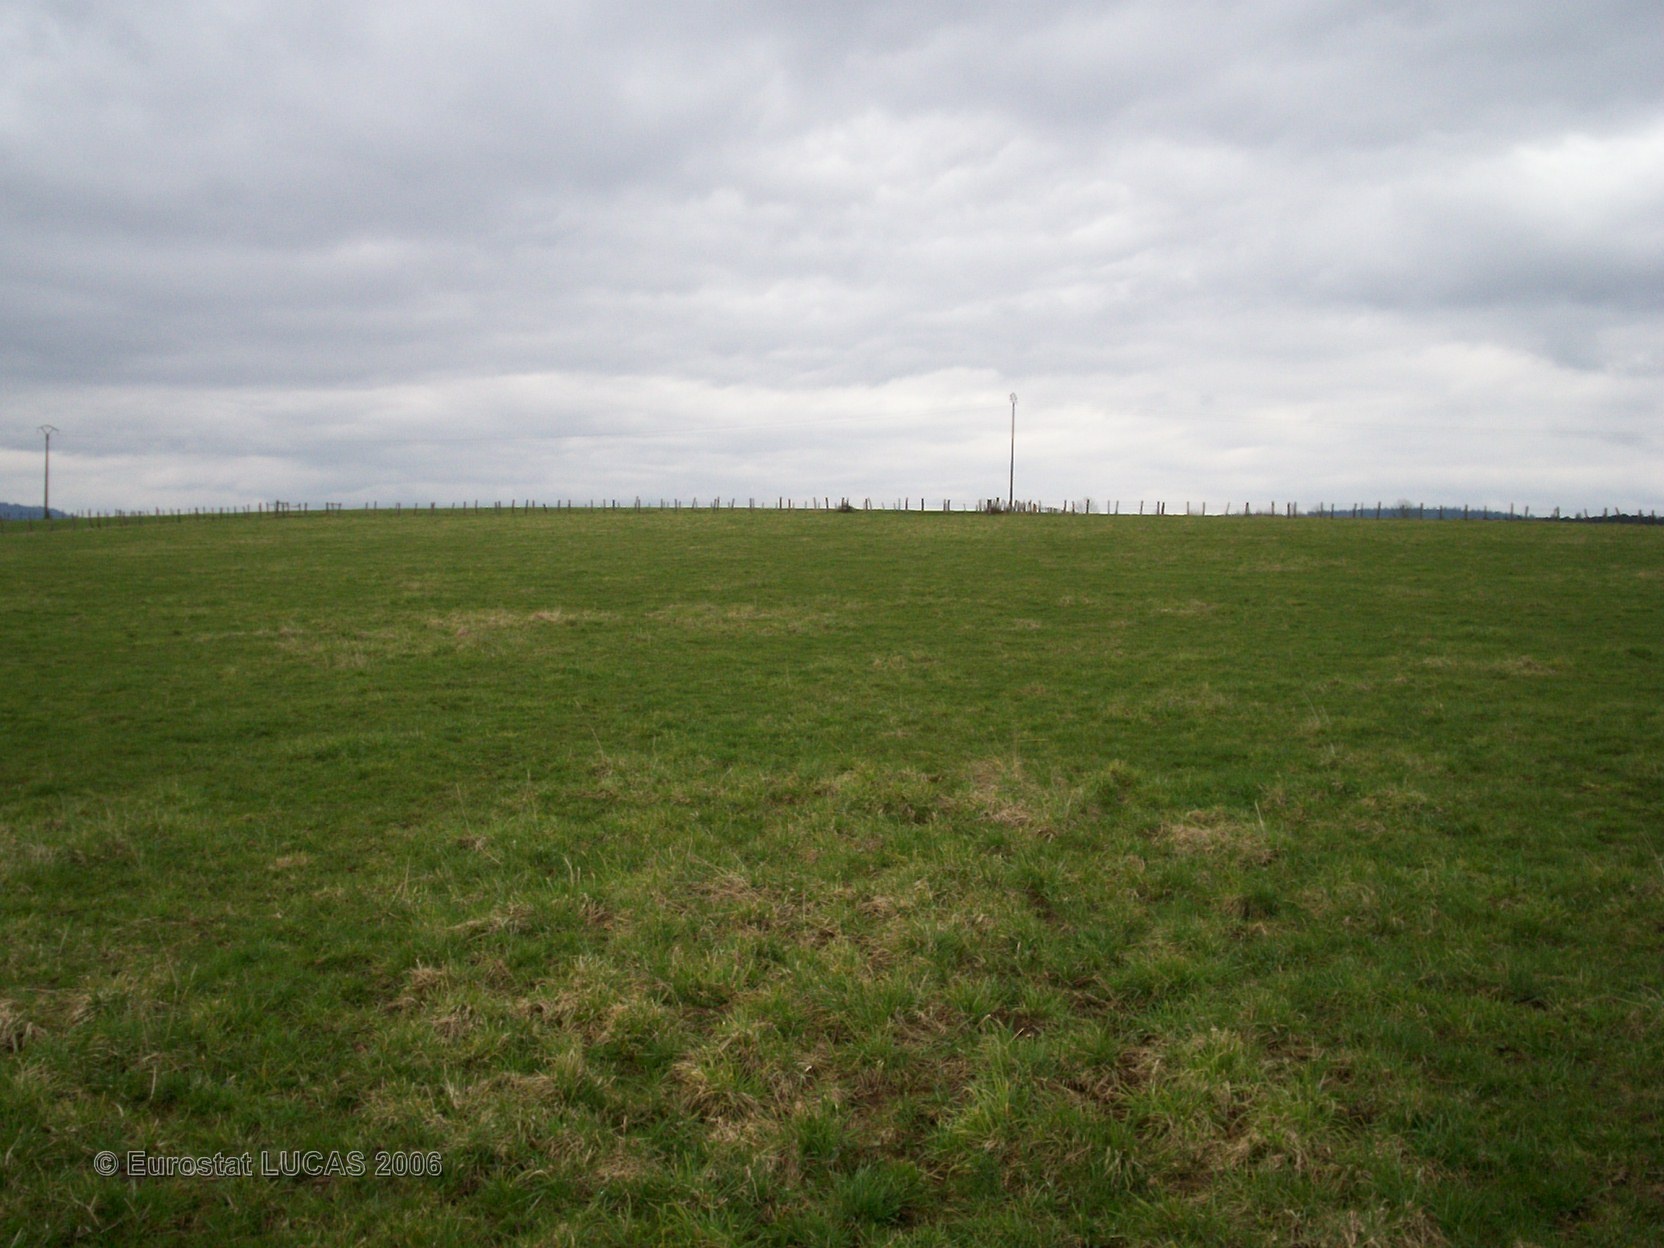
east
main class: Grassland
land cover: Grassland without tree/shrub cover
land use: Agriculture (excluding fallow land and kitchen gardens)
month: April
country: FR
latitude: 48.0060
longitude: 6.5025
